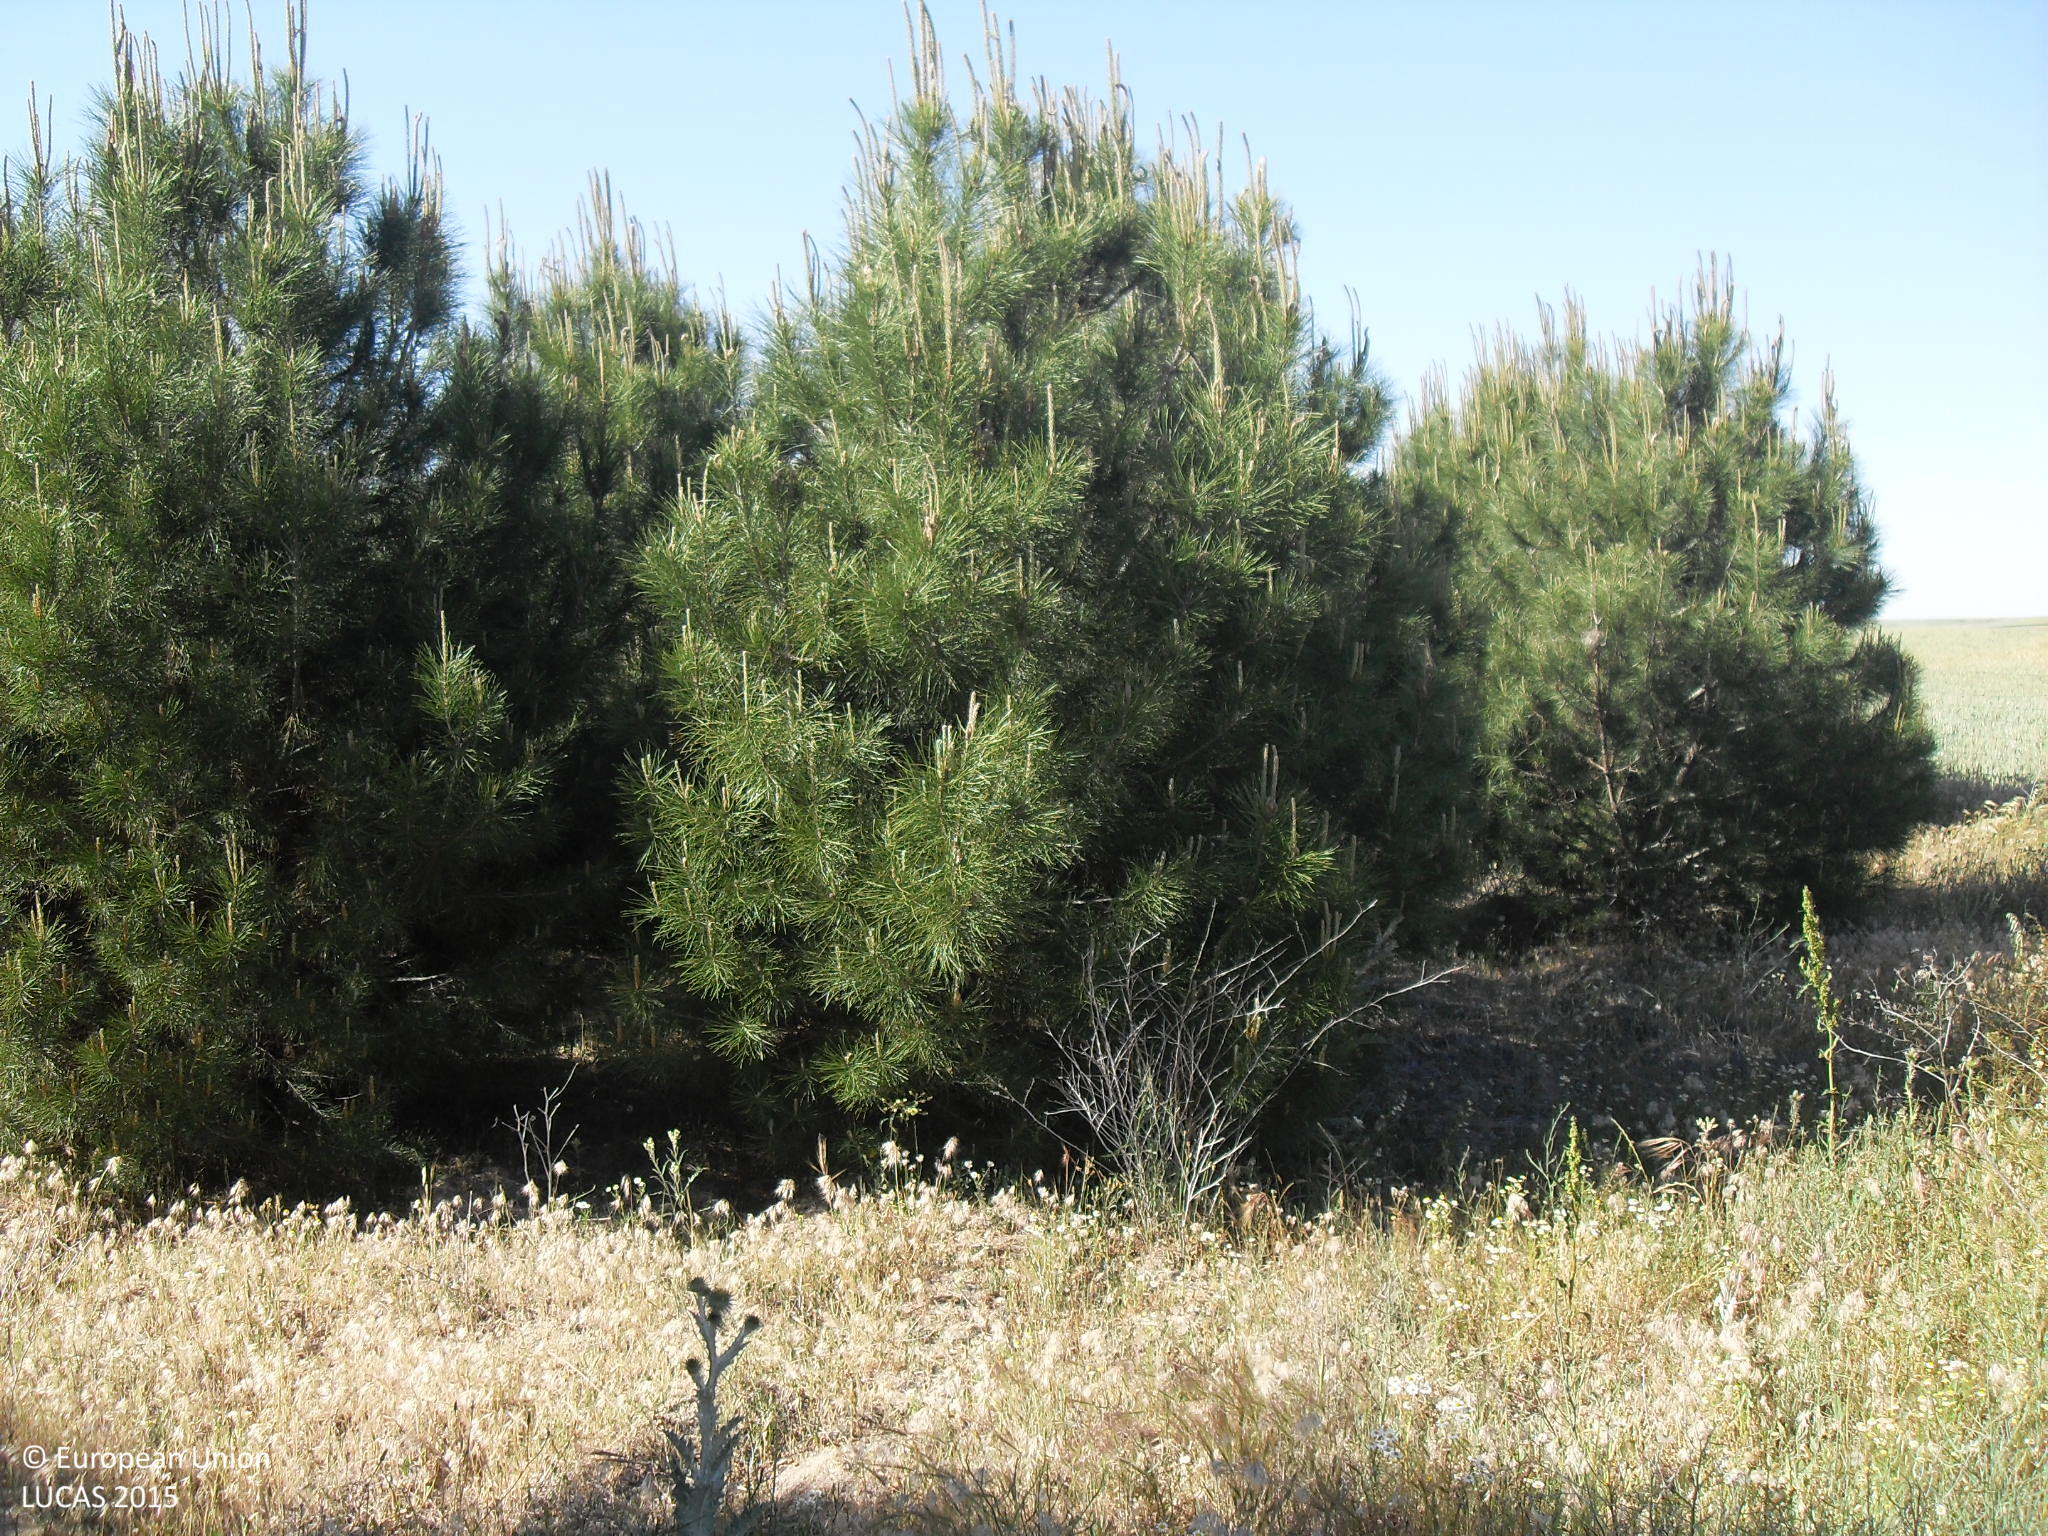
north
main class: Woodland
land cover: Pine dominated coniferous woodland
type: coniferous forest of the mediterranean region
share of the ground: 50 - 75 %
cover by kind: coniferous forest trees 60 %, herbaceous plants 40 %
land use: Forestry
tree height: < 5 m
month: May
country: ES
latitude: 41.0135
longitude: -5.2548
